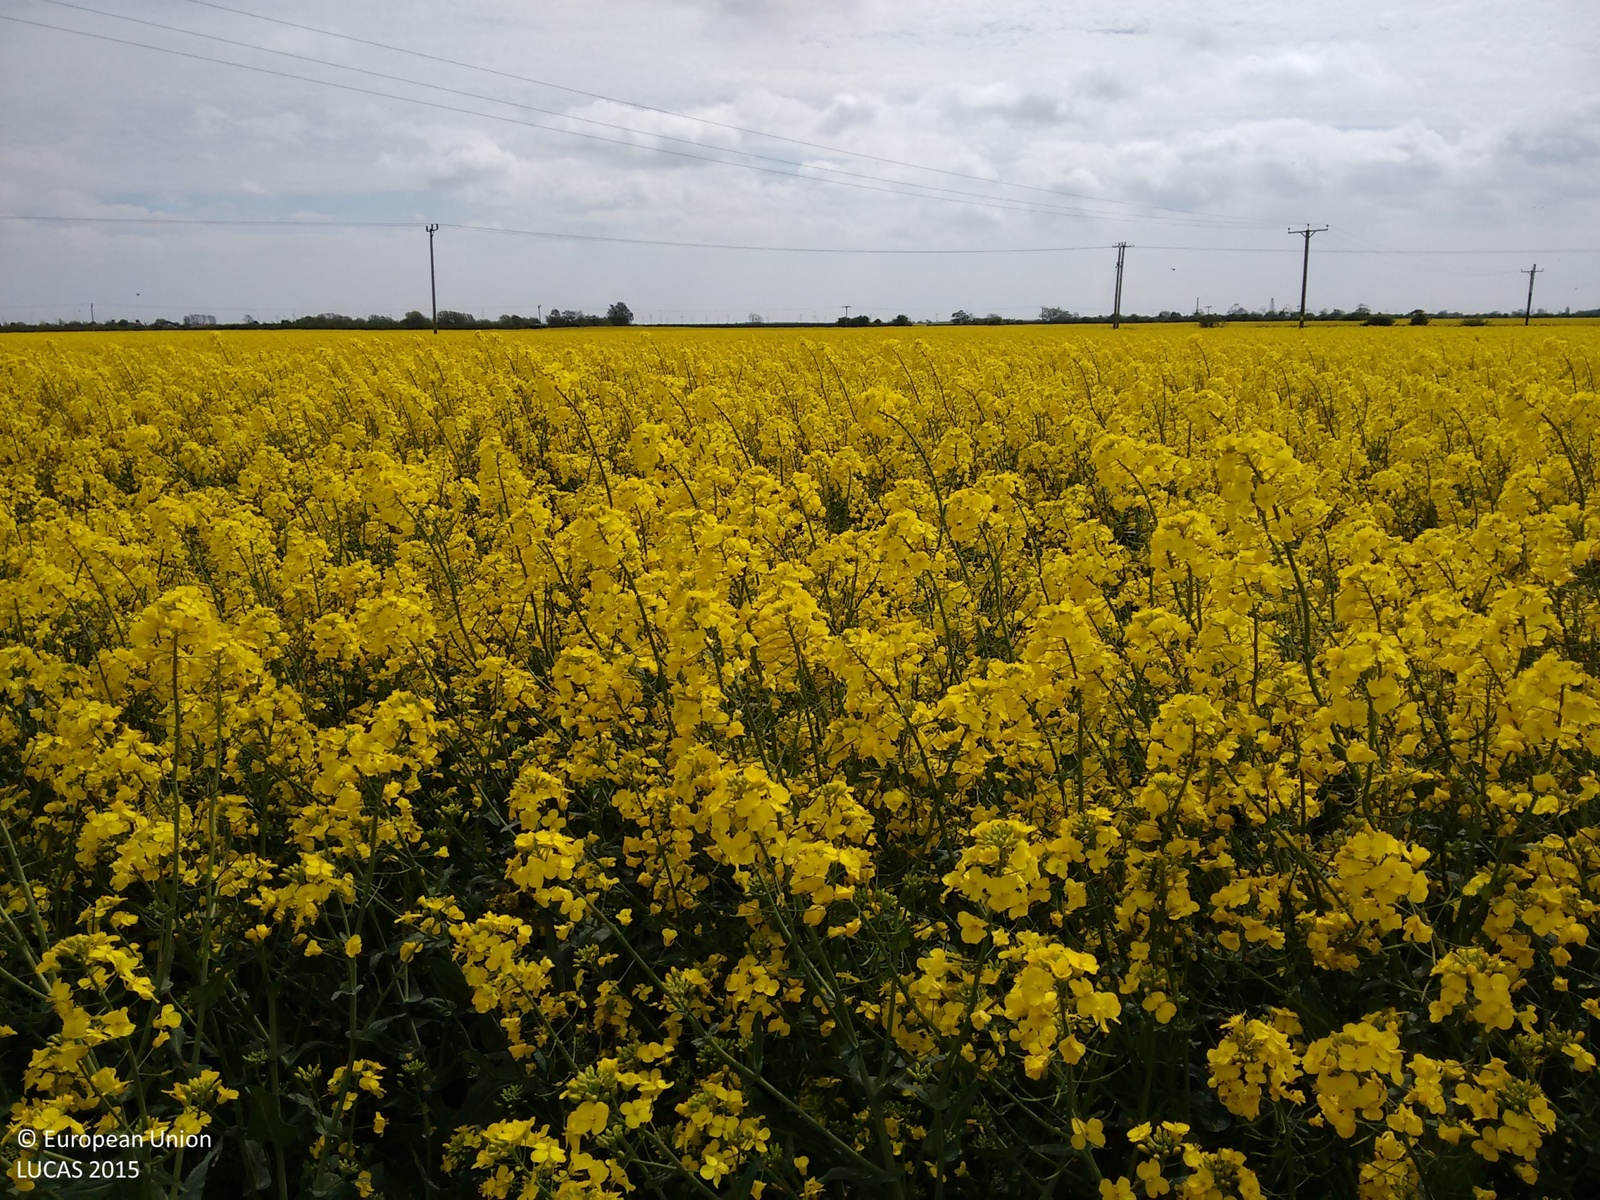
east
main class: Cropland
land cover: Rape and turnip rape
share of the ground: > 75 %
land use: Agriculture (excluding fallow land and kitchen gardens)
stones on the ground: < 10 %
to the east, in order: Rape and turnip rape; Electric lines; Rape and turnip rape; Electric lines; Rape and turnip rape
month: May
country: GB
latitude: 53.2120
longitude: 0.3129
